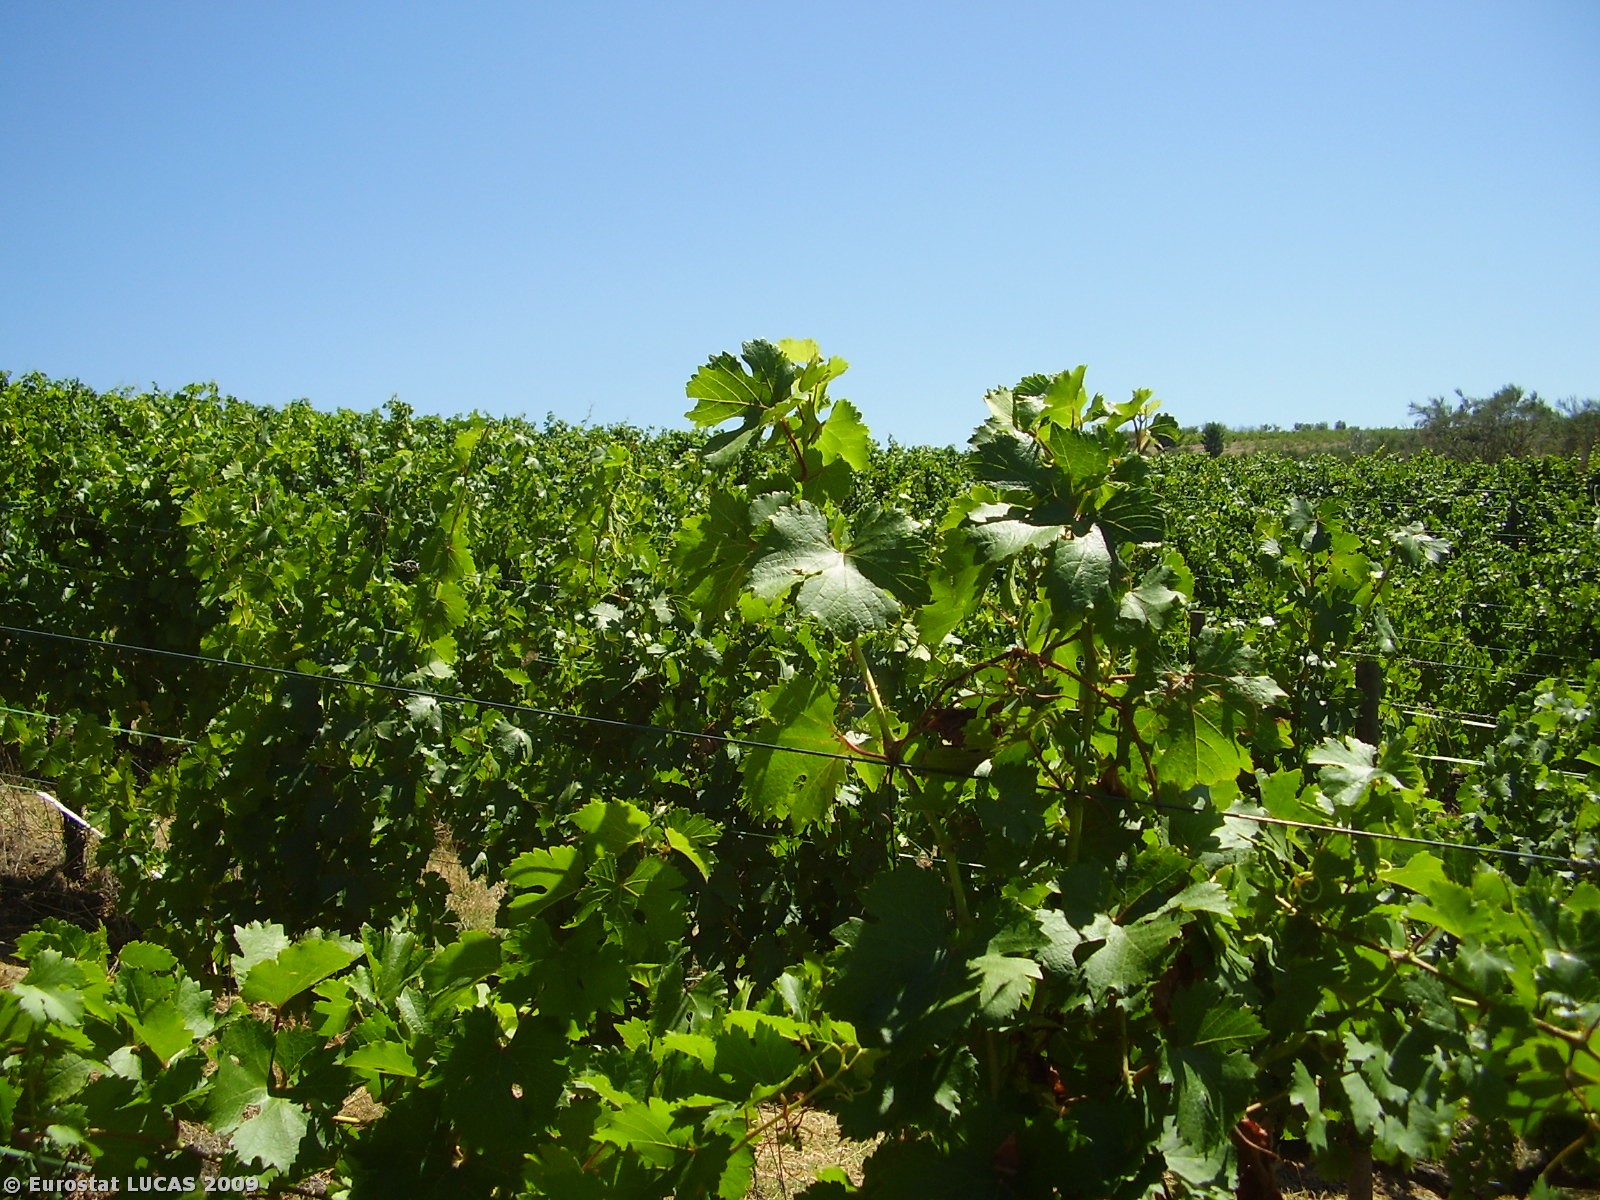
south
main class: Cropland
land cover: Vineyards
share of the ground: < 10 %
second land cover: Spontaneously vegetated surfaces
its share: > 75 %
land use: Agriculture (excluding fallow land and kitchen gardens)
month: July
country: PT
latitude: 41.6010
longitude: -7.3666
